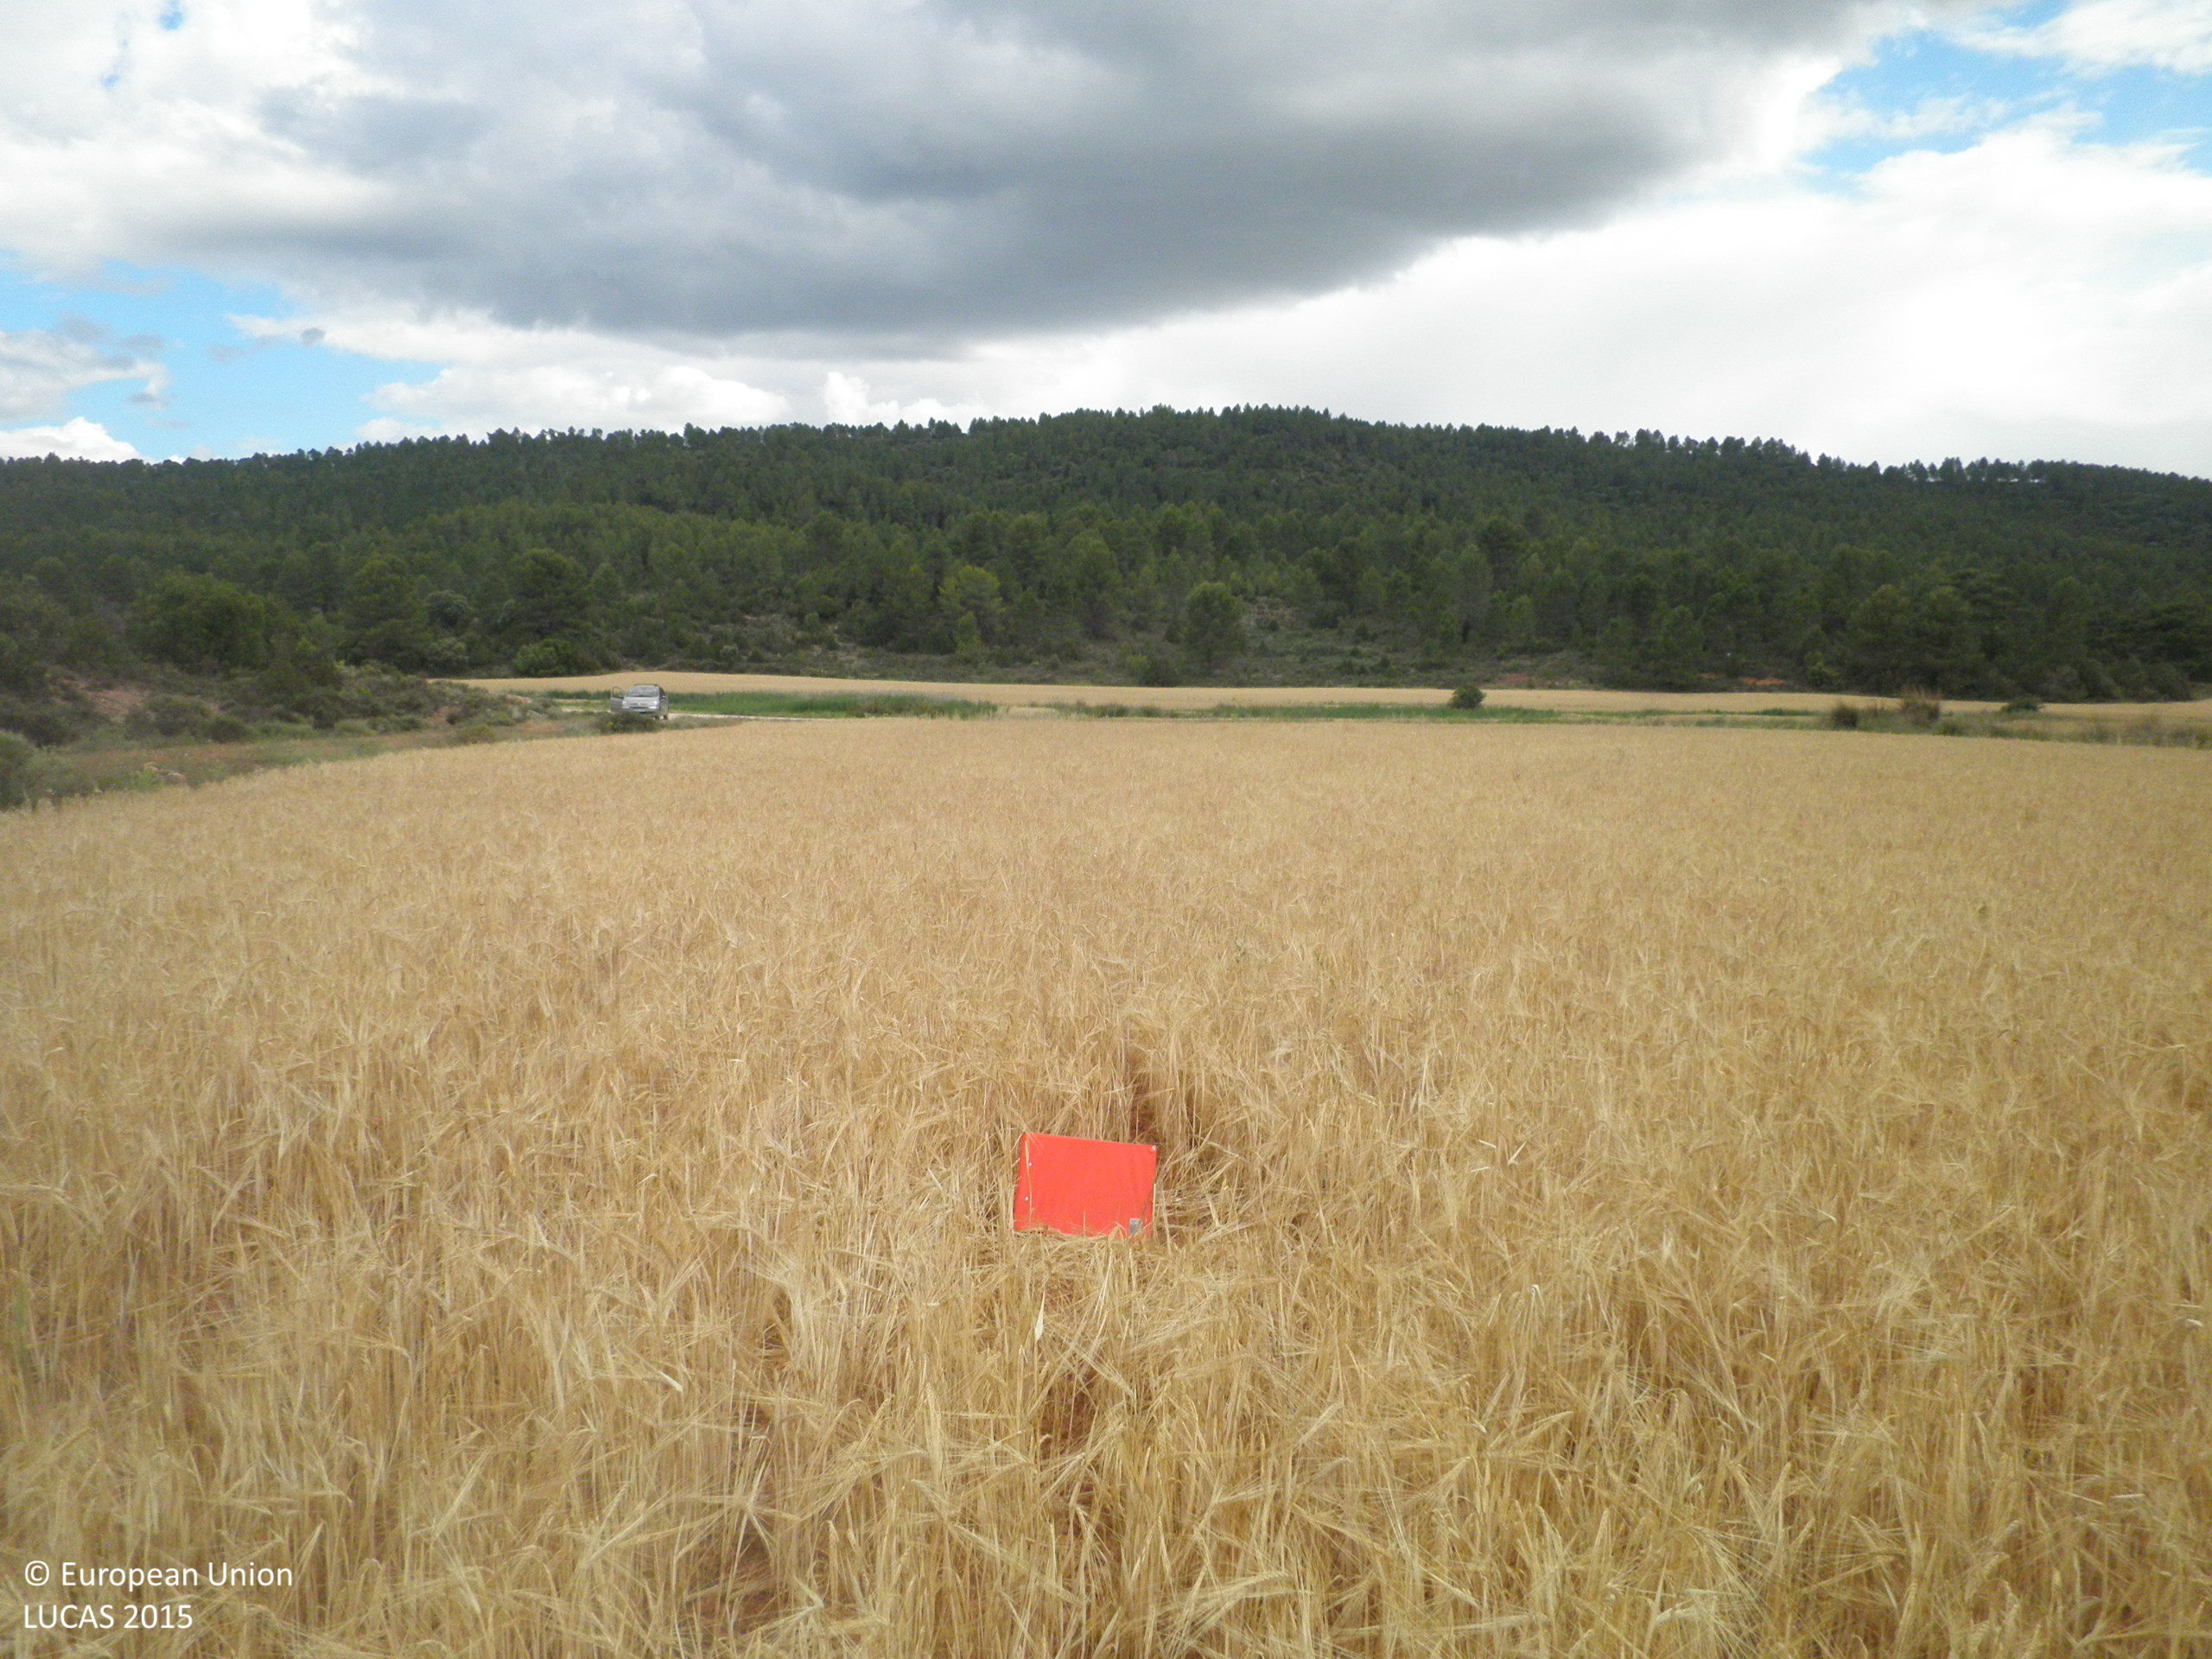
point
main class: Cropland
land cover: Barley
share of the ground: > 75 %
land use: Agriculture (excluding fallow land and kitchen gardens)
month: June
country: ES
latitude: 39.7485
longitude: -1.6906
